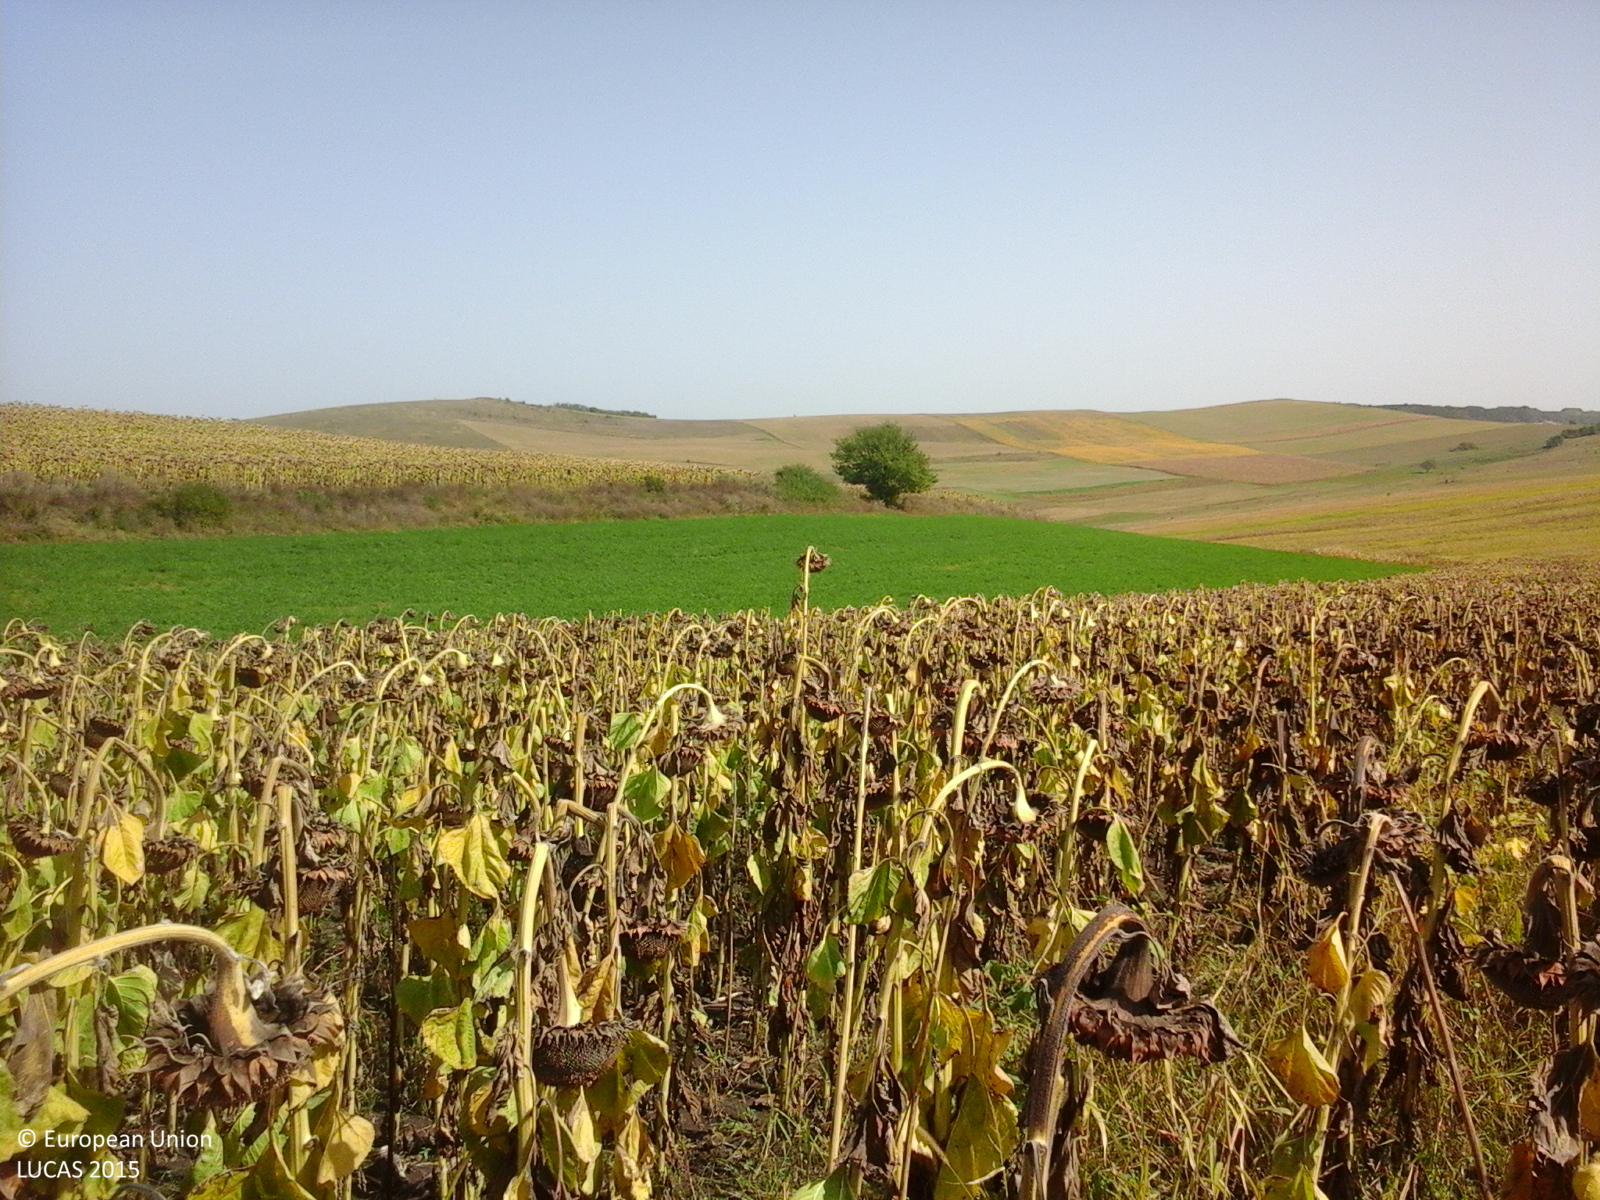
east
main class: Cropland
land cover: Sunflower
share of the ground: > 75 %
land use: Agriculture (excluding fallow land and kitchen gardens)
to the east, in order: Sunflower; Lucerne; Single bushes/trees; Shruby margins; Sunflower; Shruby margins; Tracks; Shruby margins; Sunflower
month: September
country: RO
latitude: 46.7670
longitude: 24.2116
